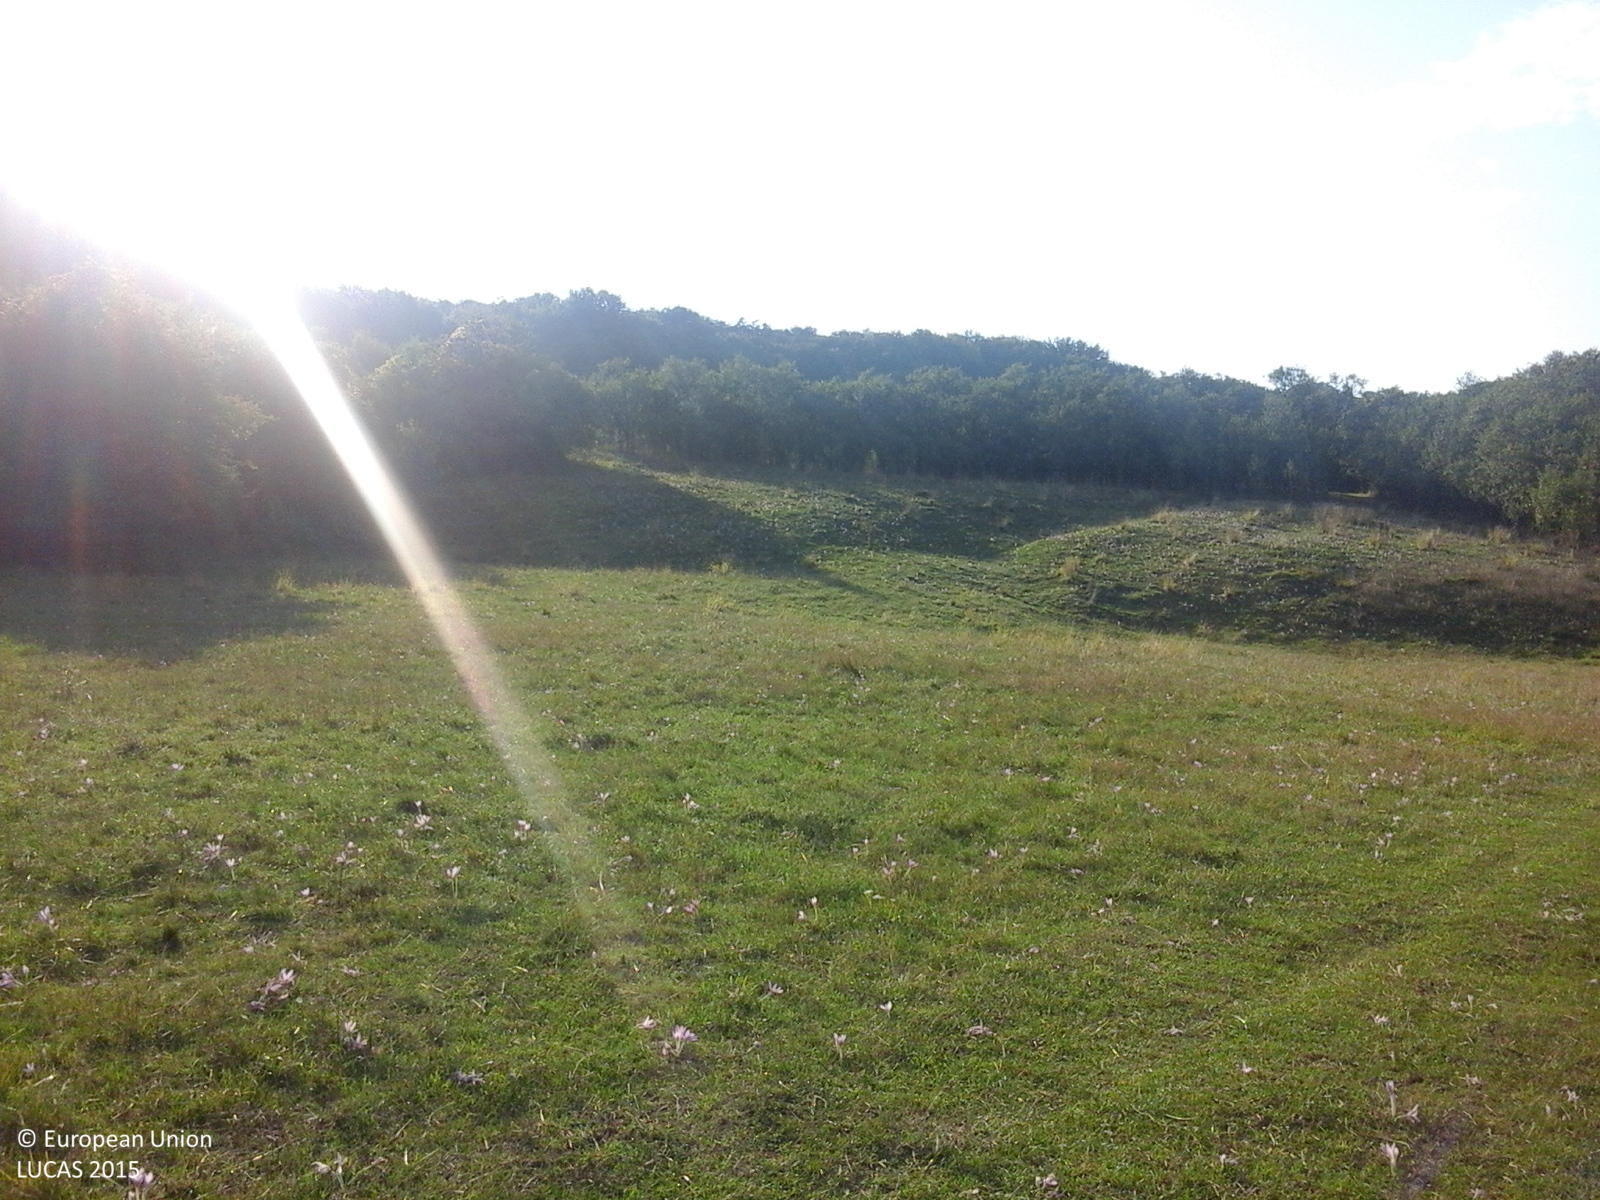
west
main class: Grassland
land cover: Grassland without tree/shrub cover
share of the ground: > 75 %
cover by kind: herbaceous plants 100 %
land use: Agriculture (excluding fallow land and kitchen gardens)
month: September
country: RO
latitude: 45.7732
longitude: 22.8480
